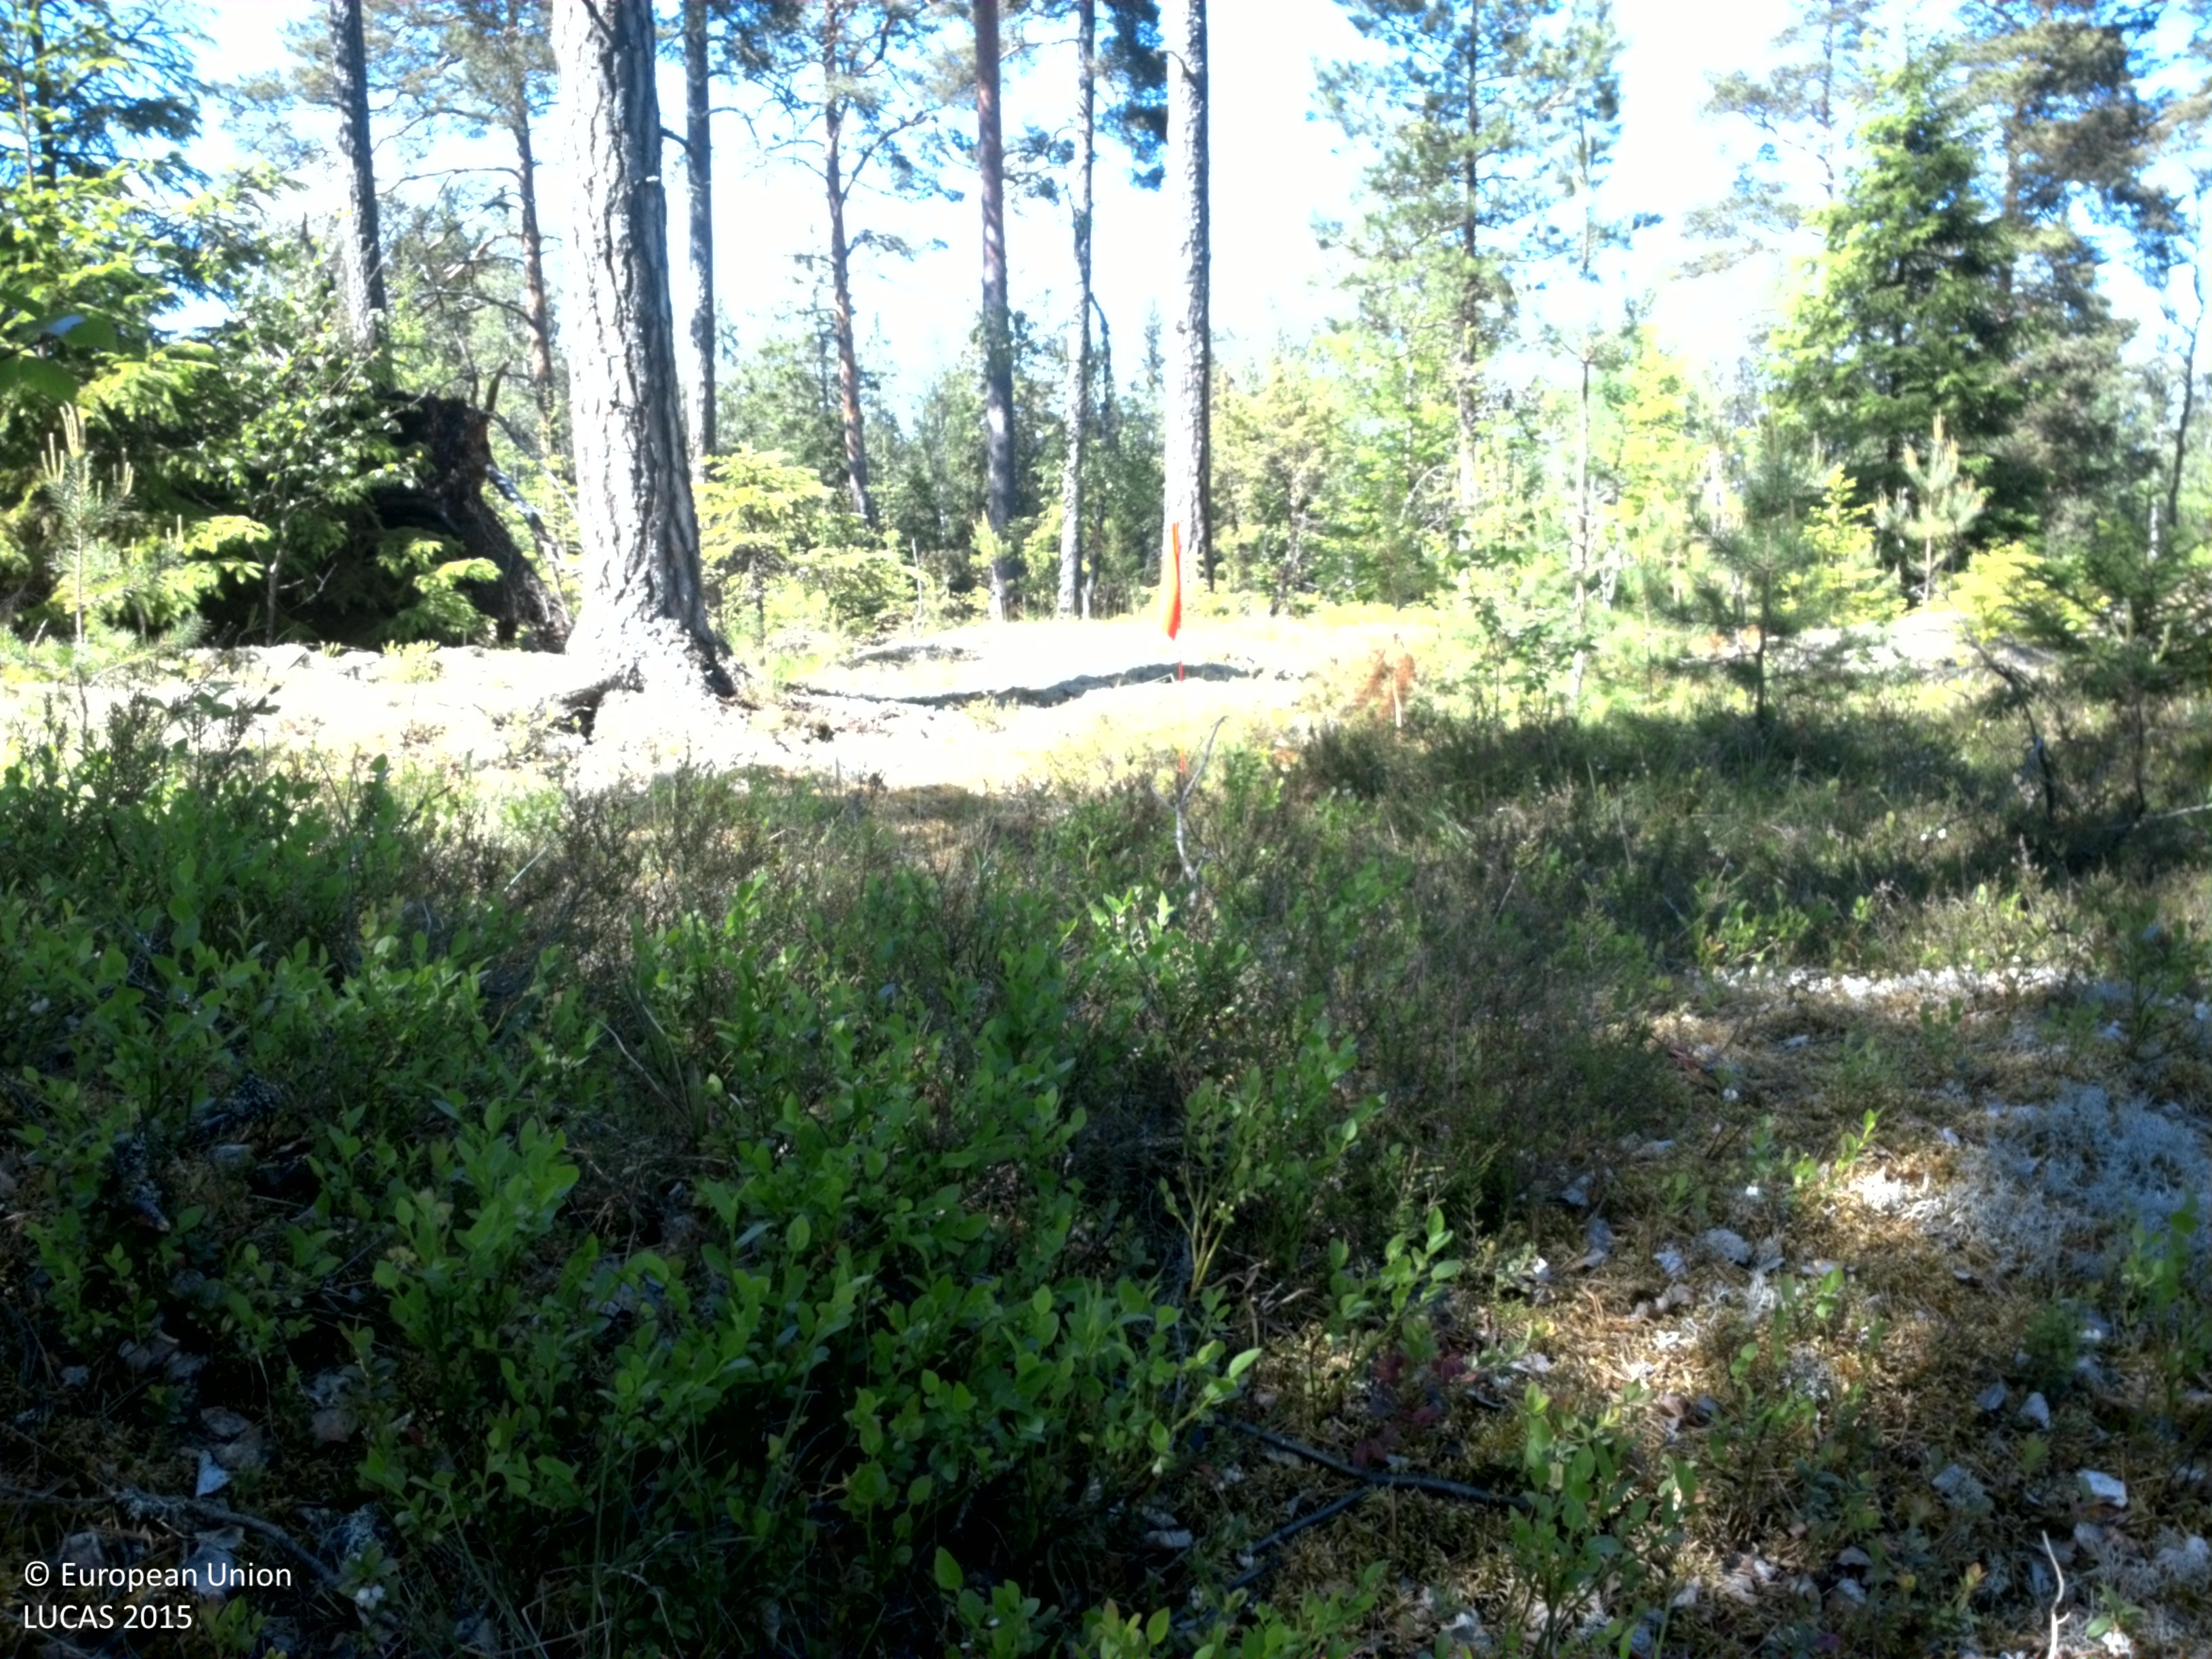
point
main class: Woodland
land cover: Pine dominated coniferous woodland
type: boreal forest
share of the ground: 25 - 50 %
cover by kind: herbaceous plants 35 %, coniferous forest trees 30 %, lichens and mosses 30 %, broadleaved forest trees 5 %
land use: Forestry
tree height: > 5 m
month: June
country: SE
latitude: 60.0404
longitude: 18.6692
